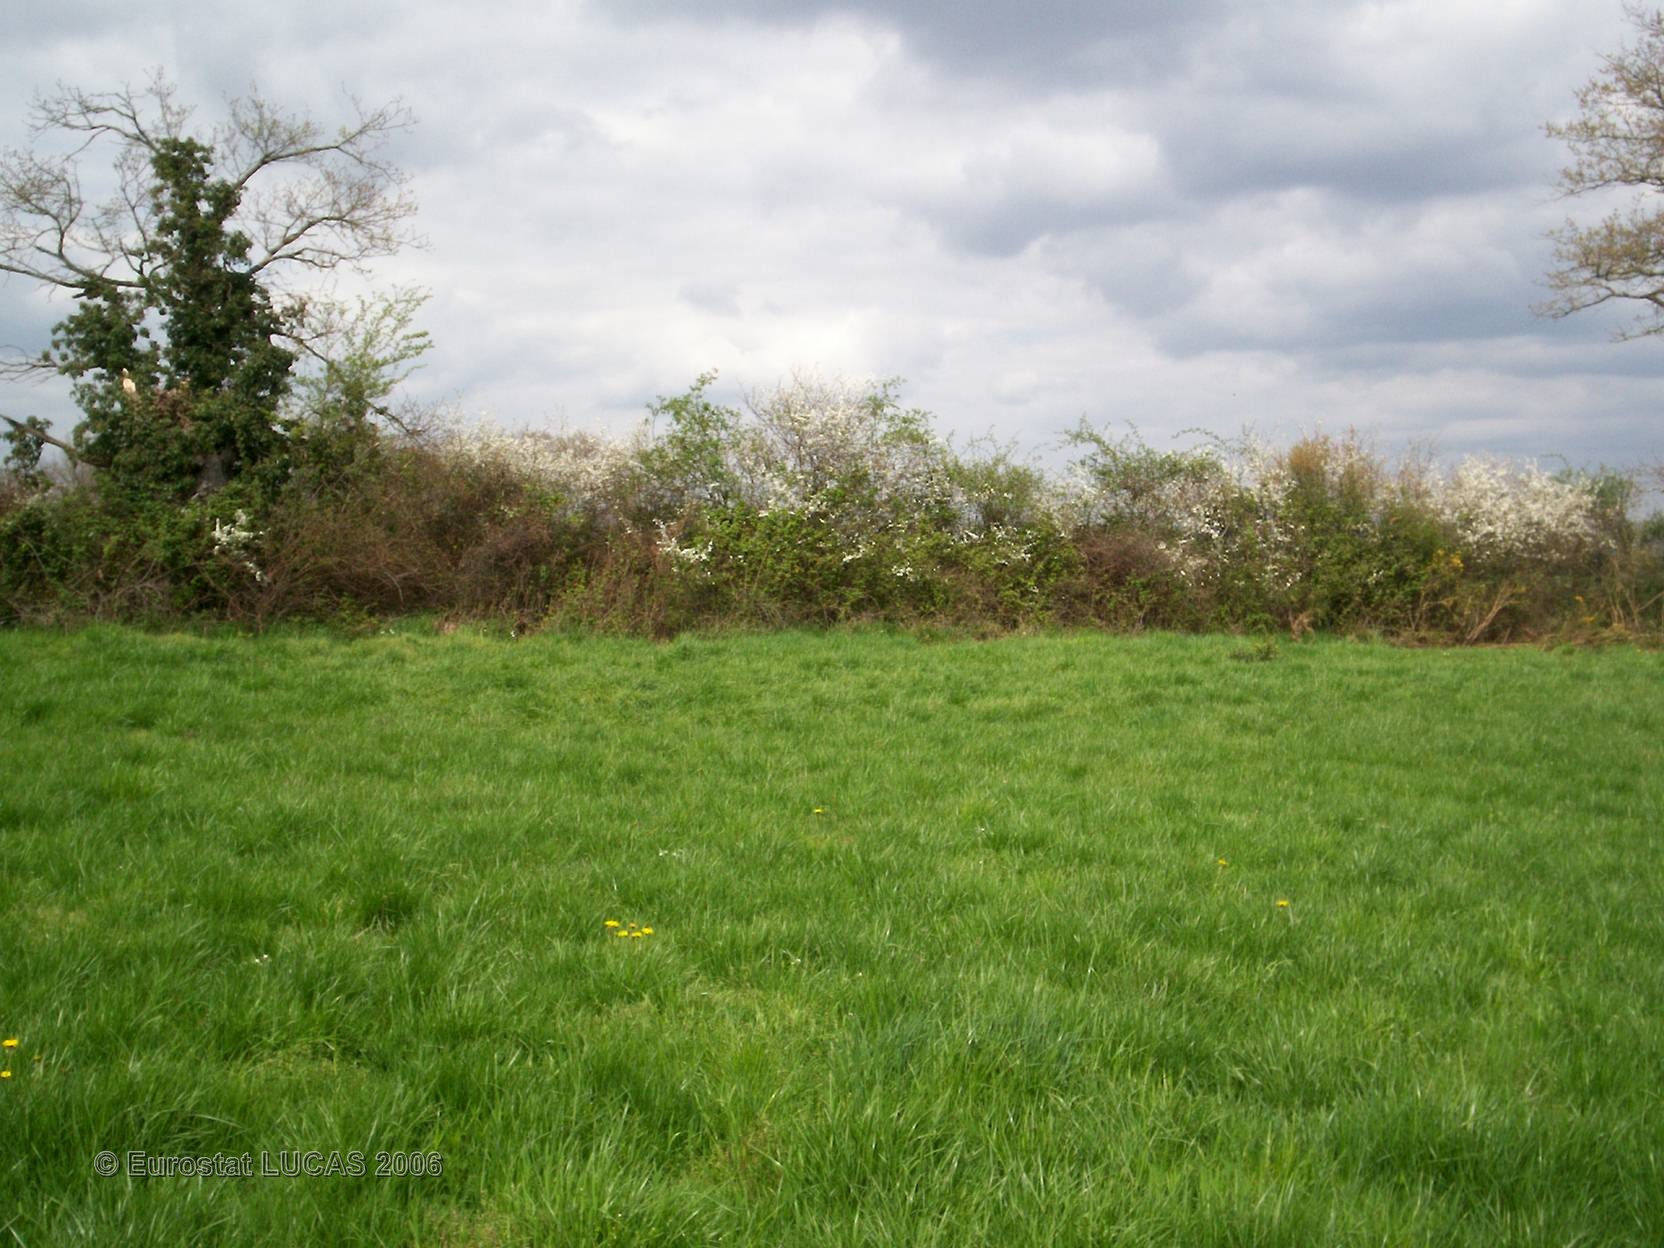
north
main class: Grassland
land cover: Grassland without tree/shrub cover
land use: Agriculture (excluding fallow land and kitchen gardens)
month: April
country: FR
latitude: 46.0709
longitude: 0.4815
